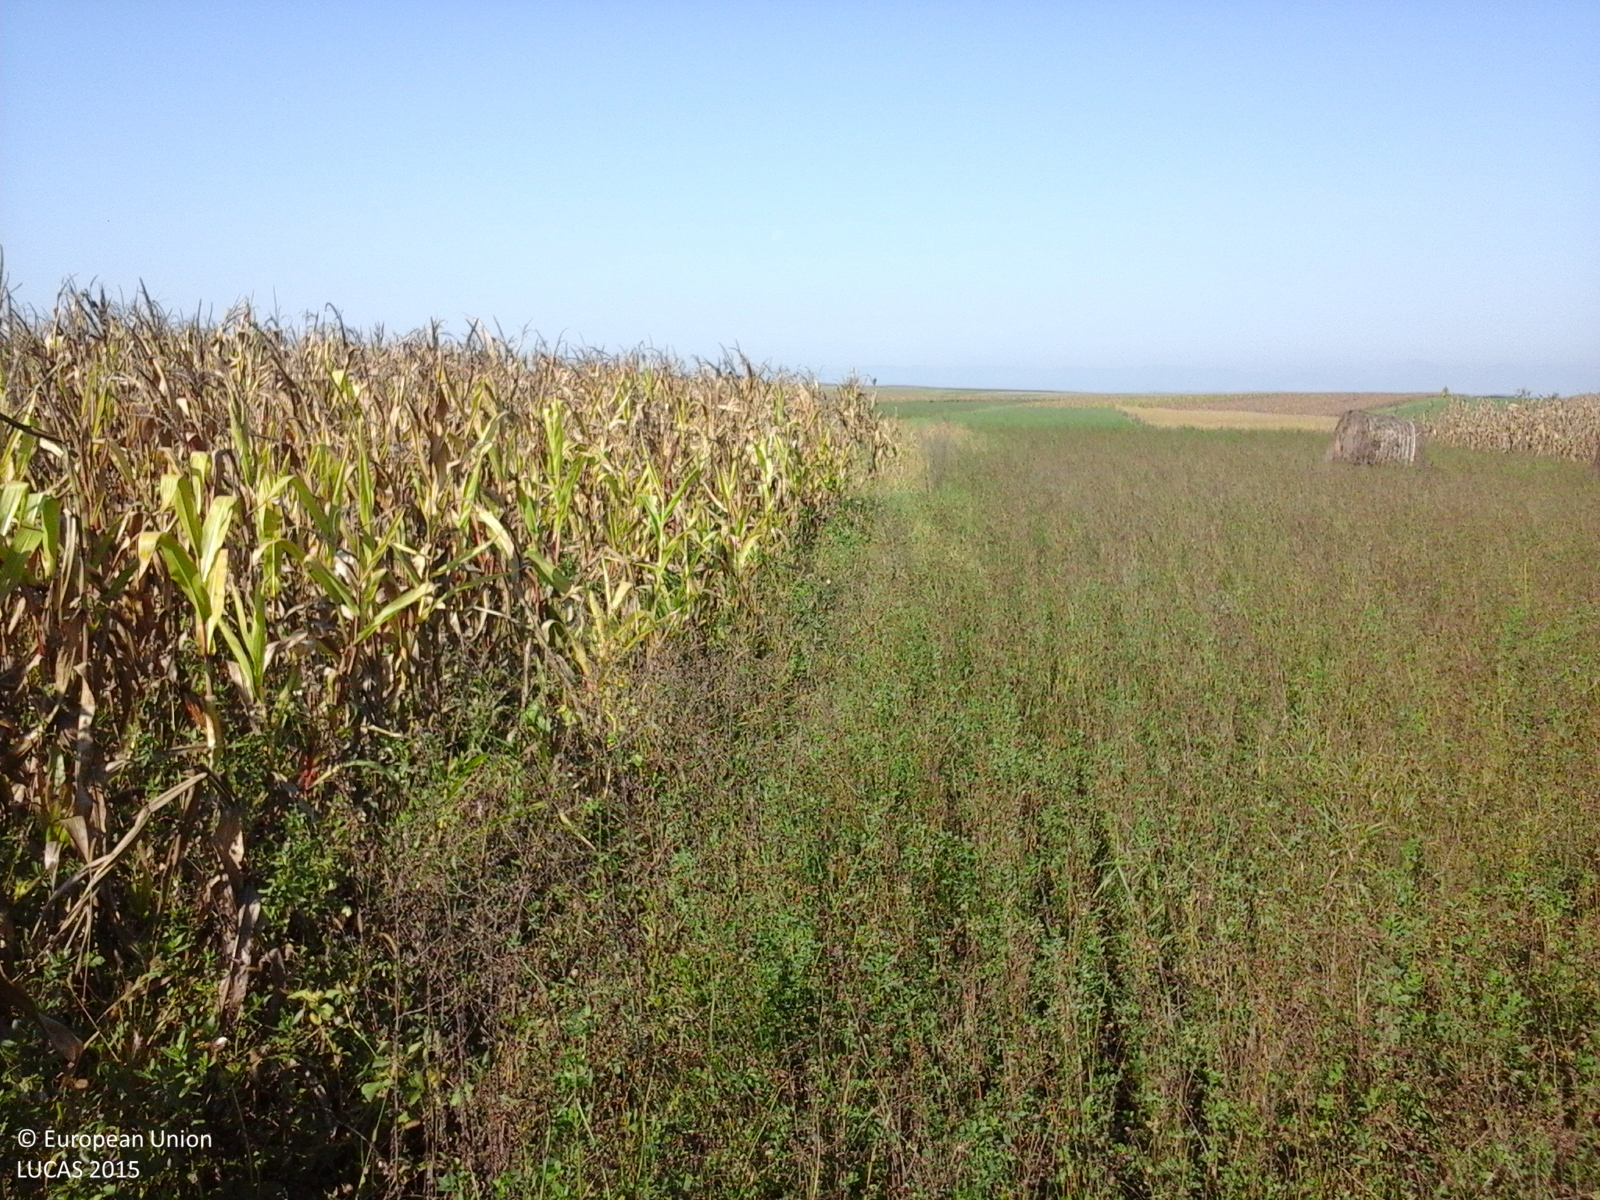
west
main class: Cropland
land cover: Lucerne
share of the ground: > 75 %
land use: Agriculture (excluding fallow land and kitchen gardens)
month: October
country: RO
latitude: 46.0673
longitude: 23.8394
